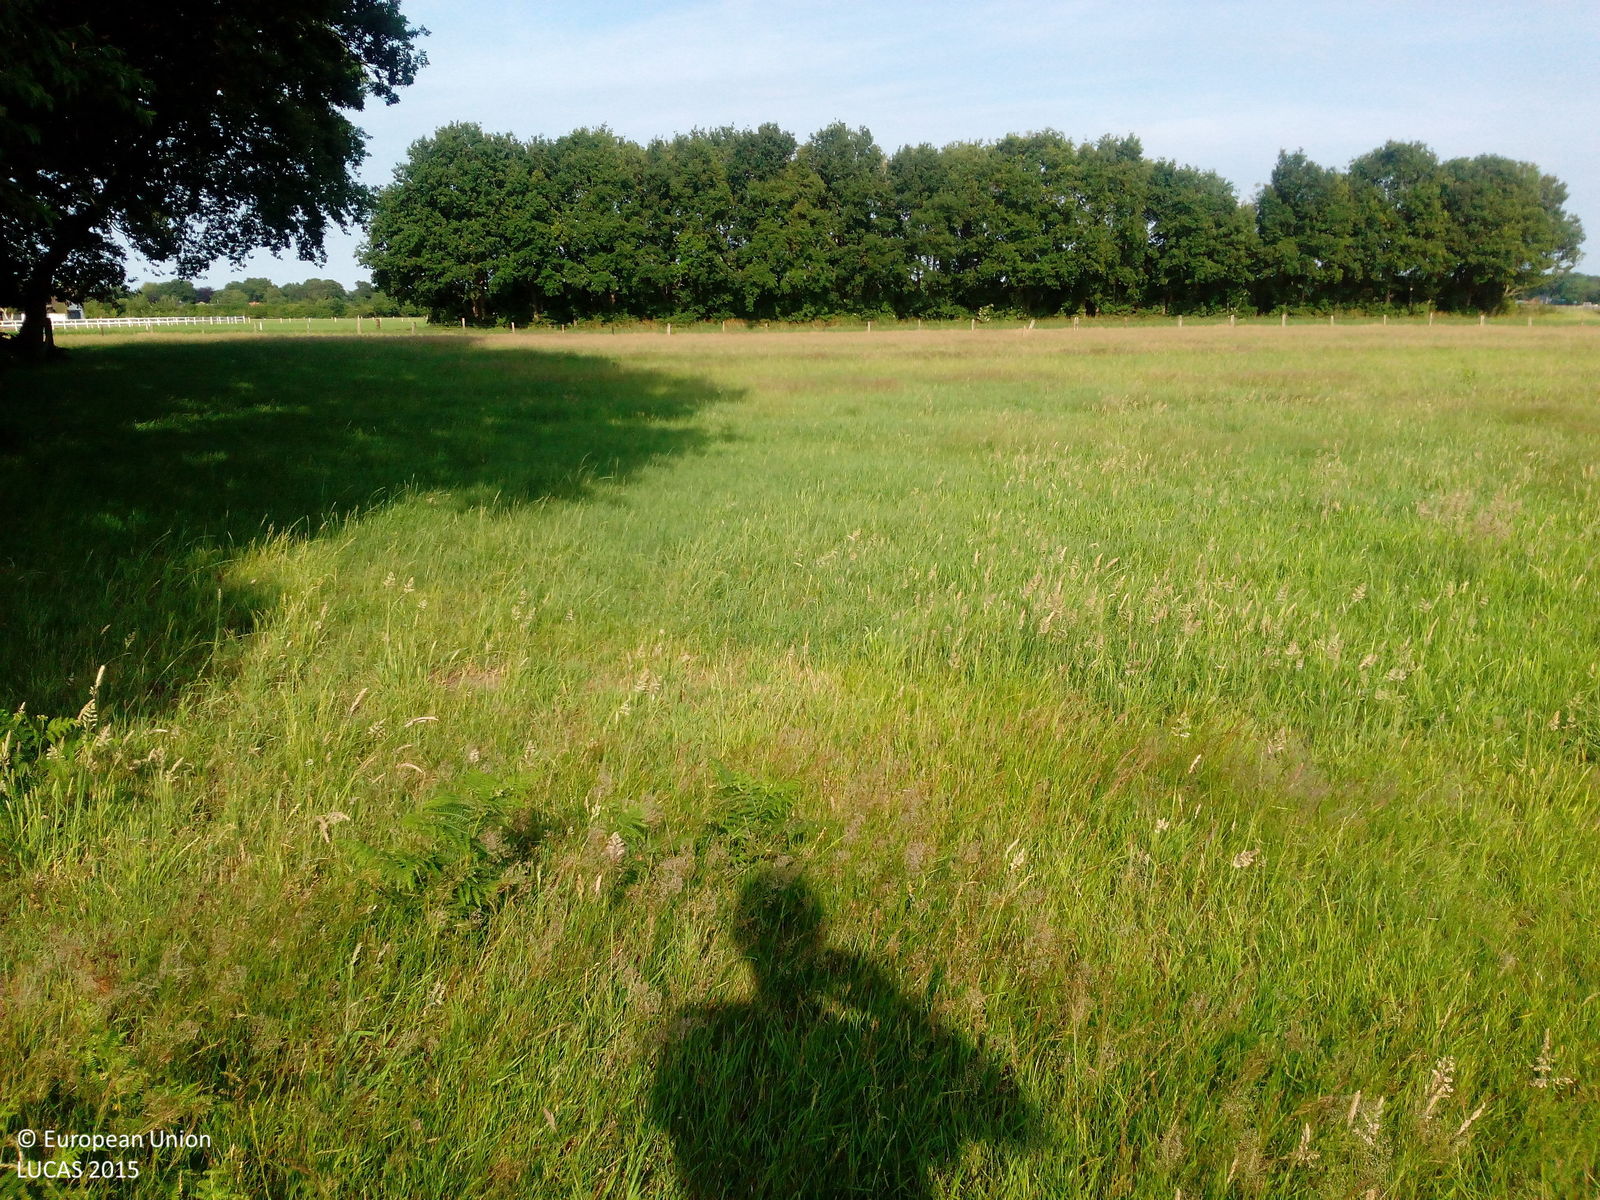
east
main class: Grassland
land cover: Grassland without tree/shrub cover
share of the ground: > 75 %
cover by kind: herbaceous plants 100 %
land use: Agriculture (excluding fallow land and kitchen gardens)
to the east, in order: Grassland without tree/shrub cover; Fences; Tracks; Fences; Grassland without tree/shrub cover; Fences; Broadleaved woodland; Fences; Grassland without tree/shrub cover; Fences; Grassland without tree/shrub cover; Maize; Grass margins; Paved roads, cycling and walking lanes; Grass margins; Fences; Grassland without tree/shrub cover
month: June
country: NL
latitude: 52.3525
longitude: 5.6676
